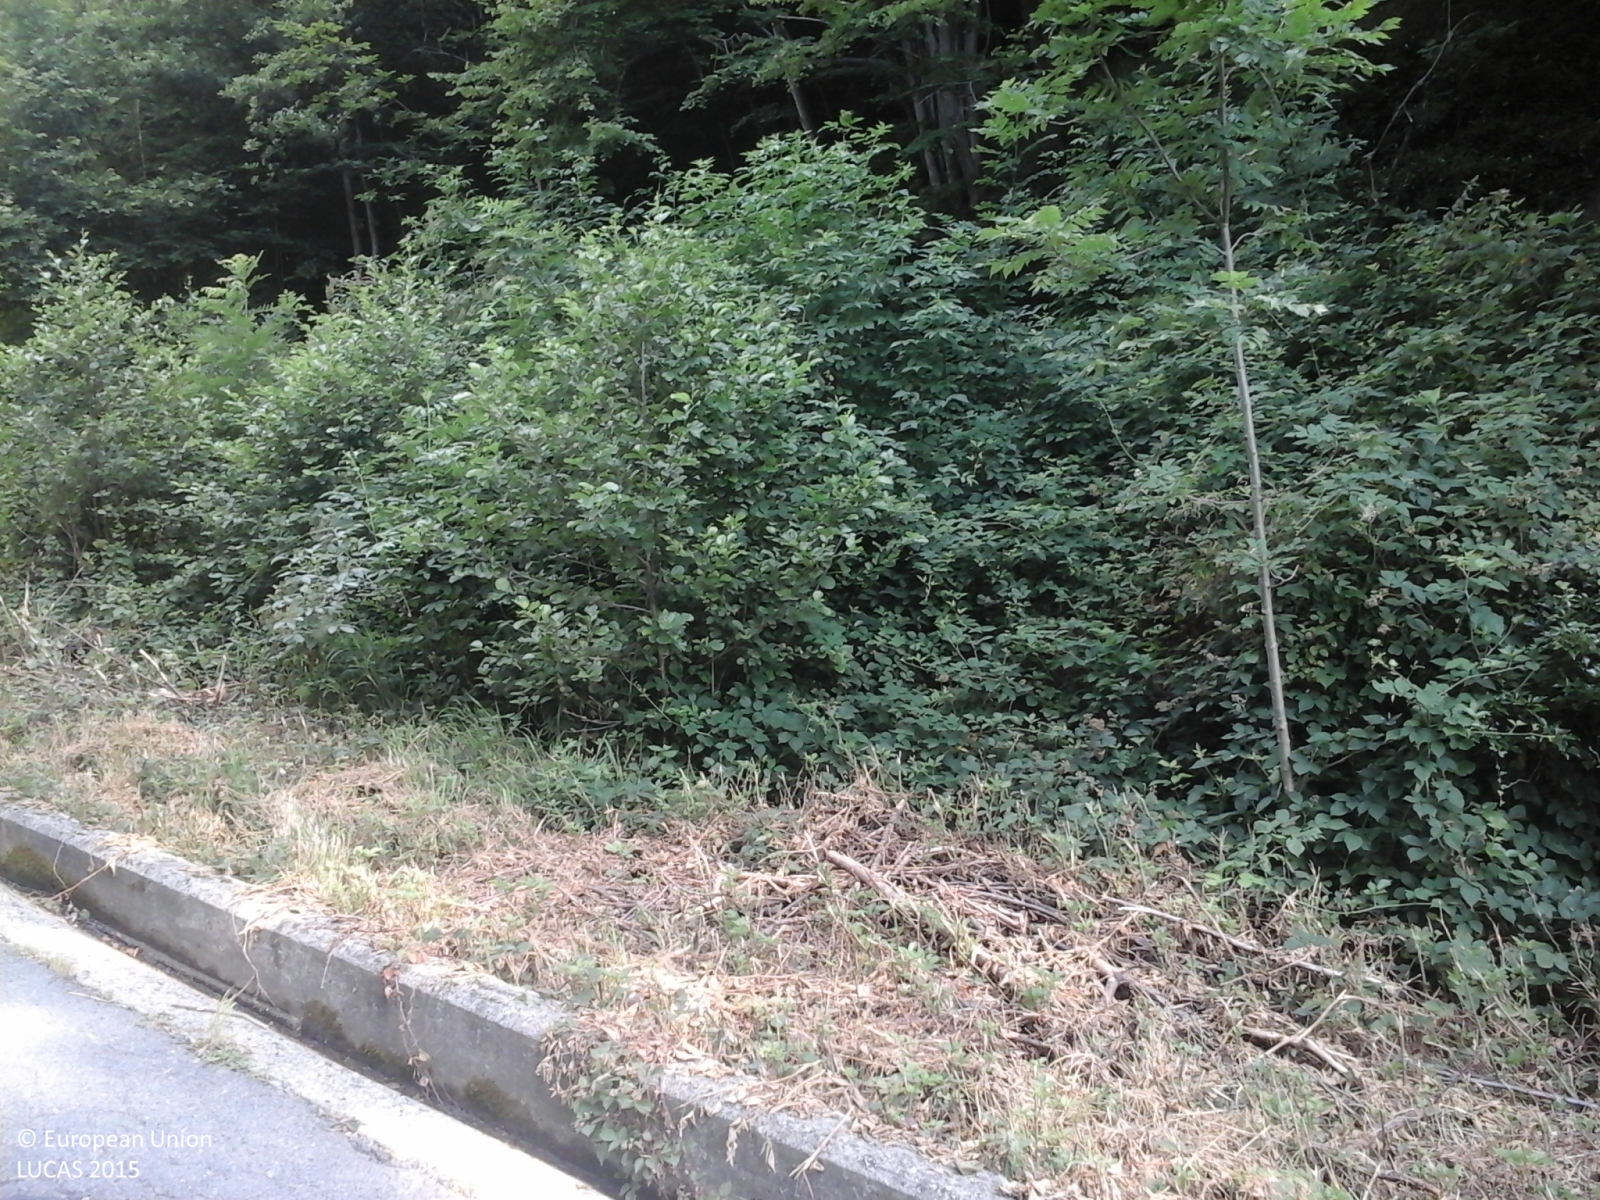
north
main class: Woodland
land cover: Broadleaved woodland
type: mesophytic deciduous forest
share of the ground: > 75 %
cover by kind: broadleaved forest trees 100 %
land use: Forestry
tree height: > 5 m
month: July
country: IT
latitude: 45.0545
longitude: 7.2746
